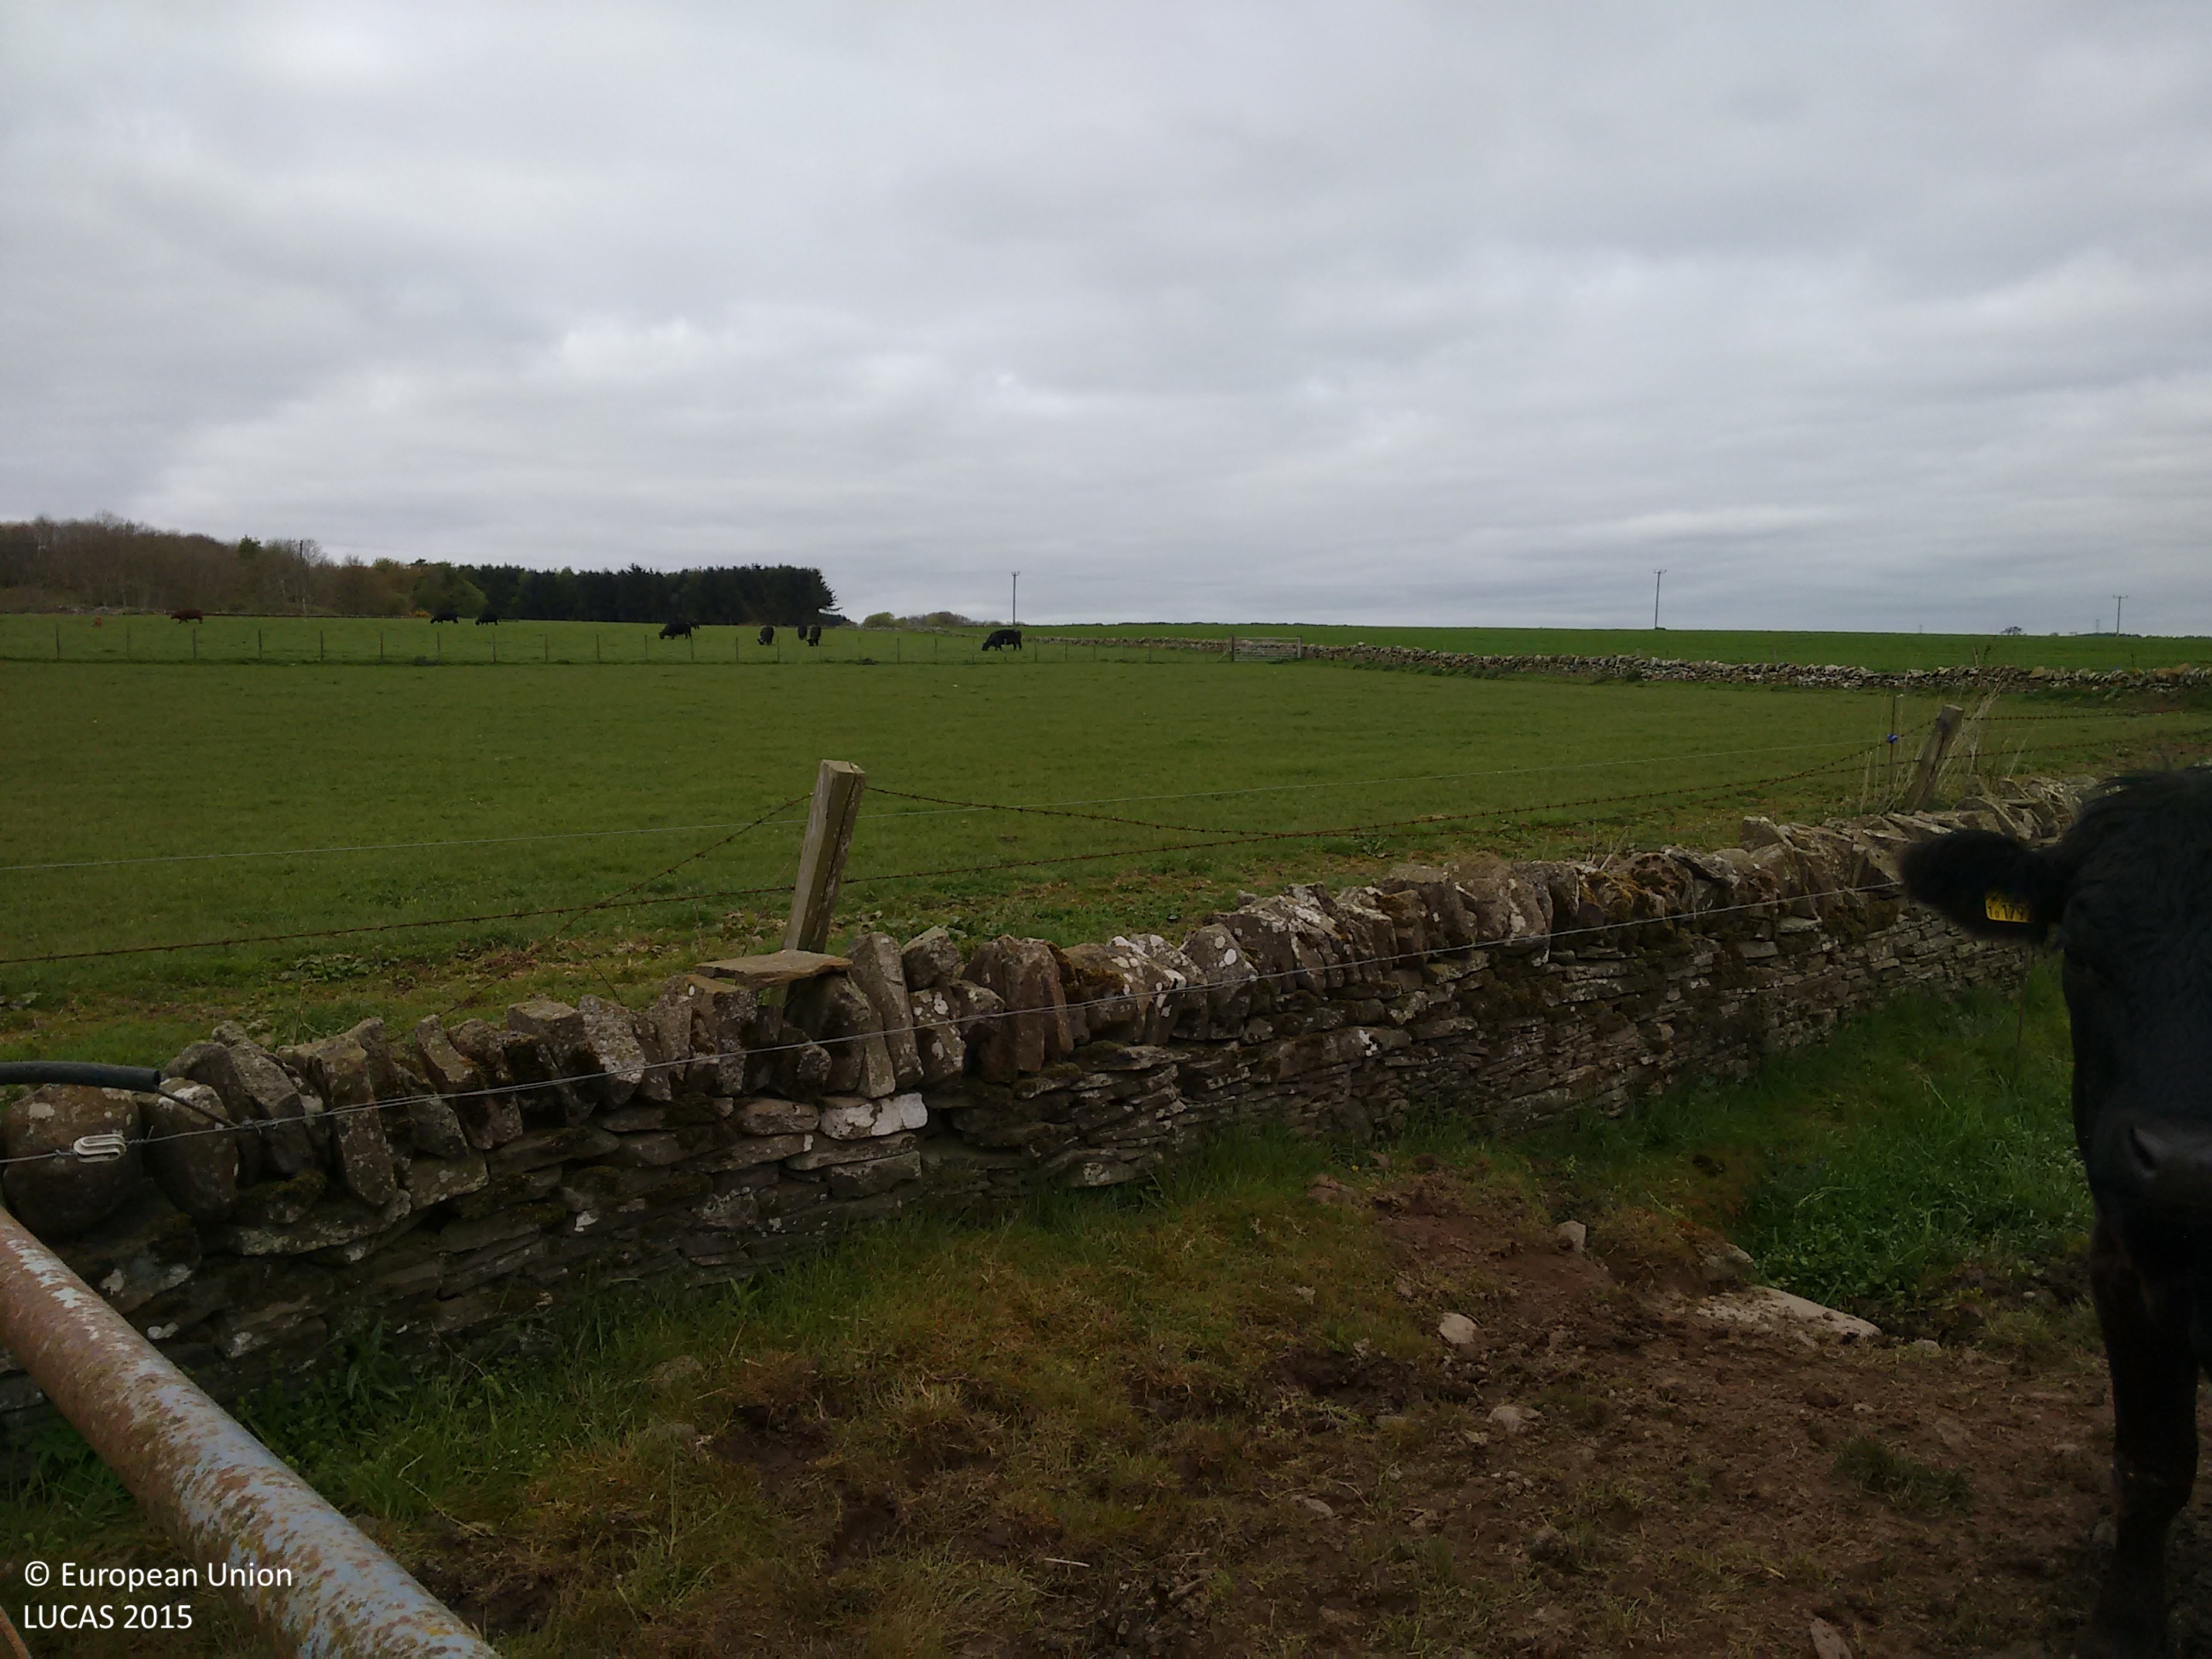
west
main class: Grassland
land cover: Grassland without tree/shrub cover
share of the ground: 50 - 75 %
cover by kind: herbaceous plants 75 %, unconsolidated bare surface 25 %
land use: Agriculture (excluding fallow land and kitchen gardens)
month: May
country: GB
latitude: 56.6763
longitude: -2.7753
